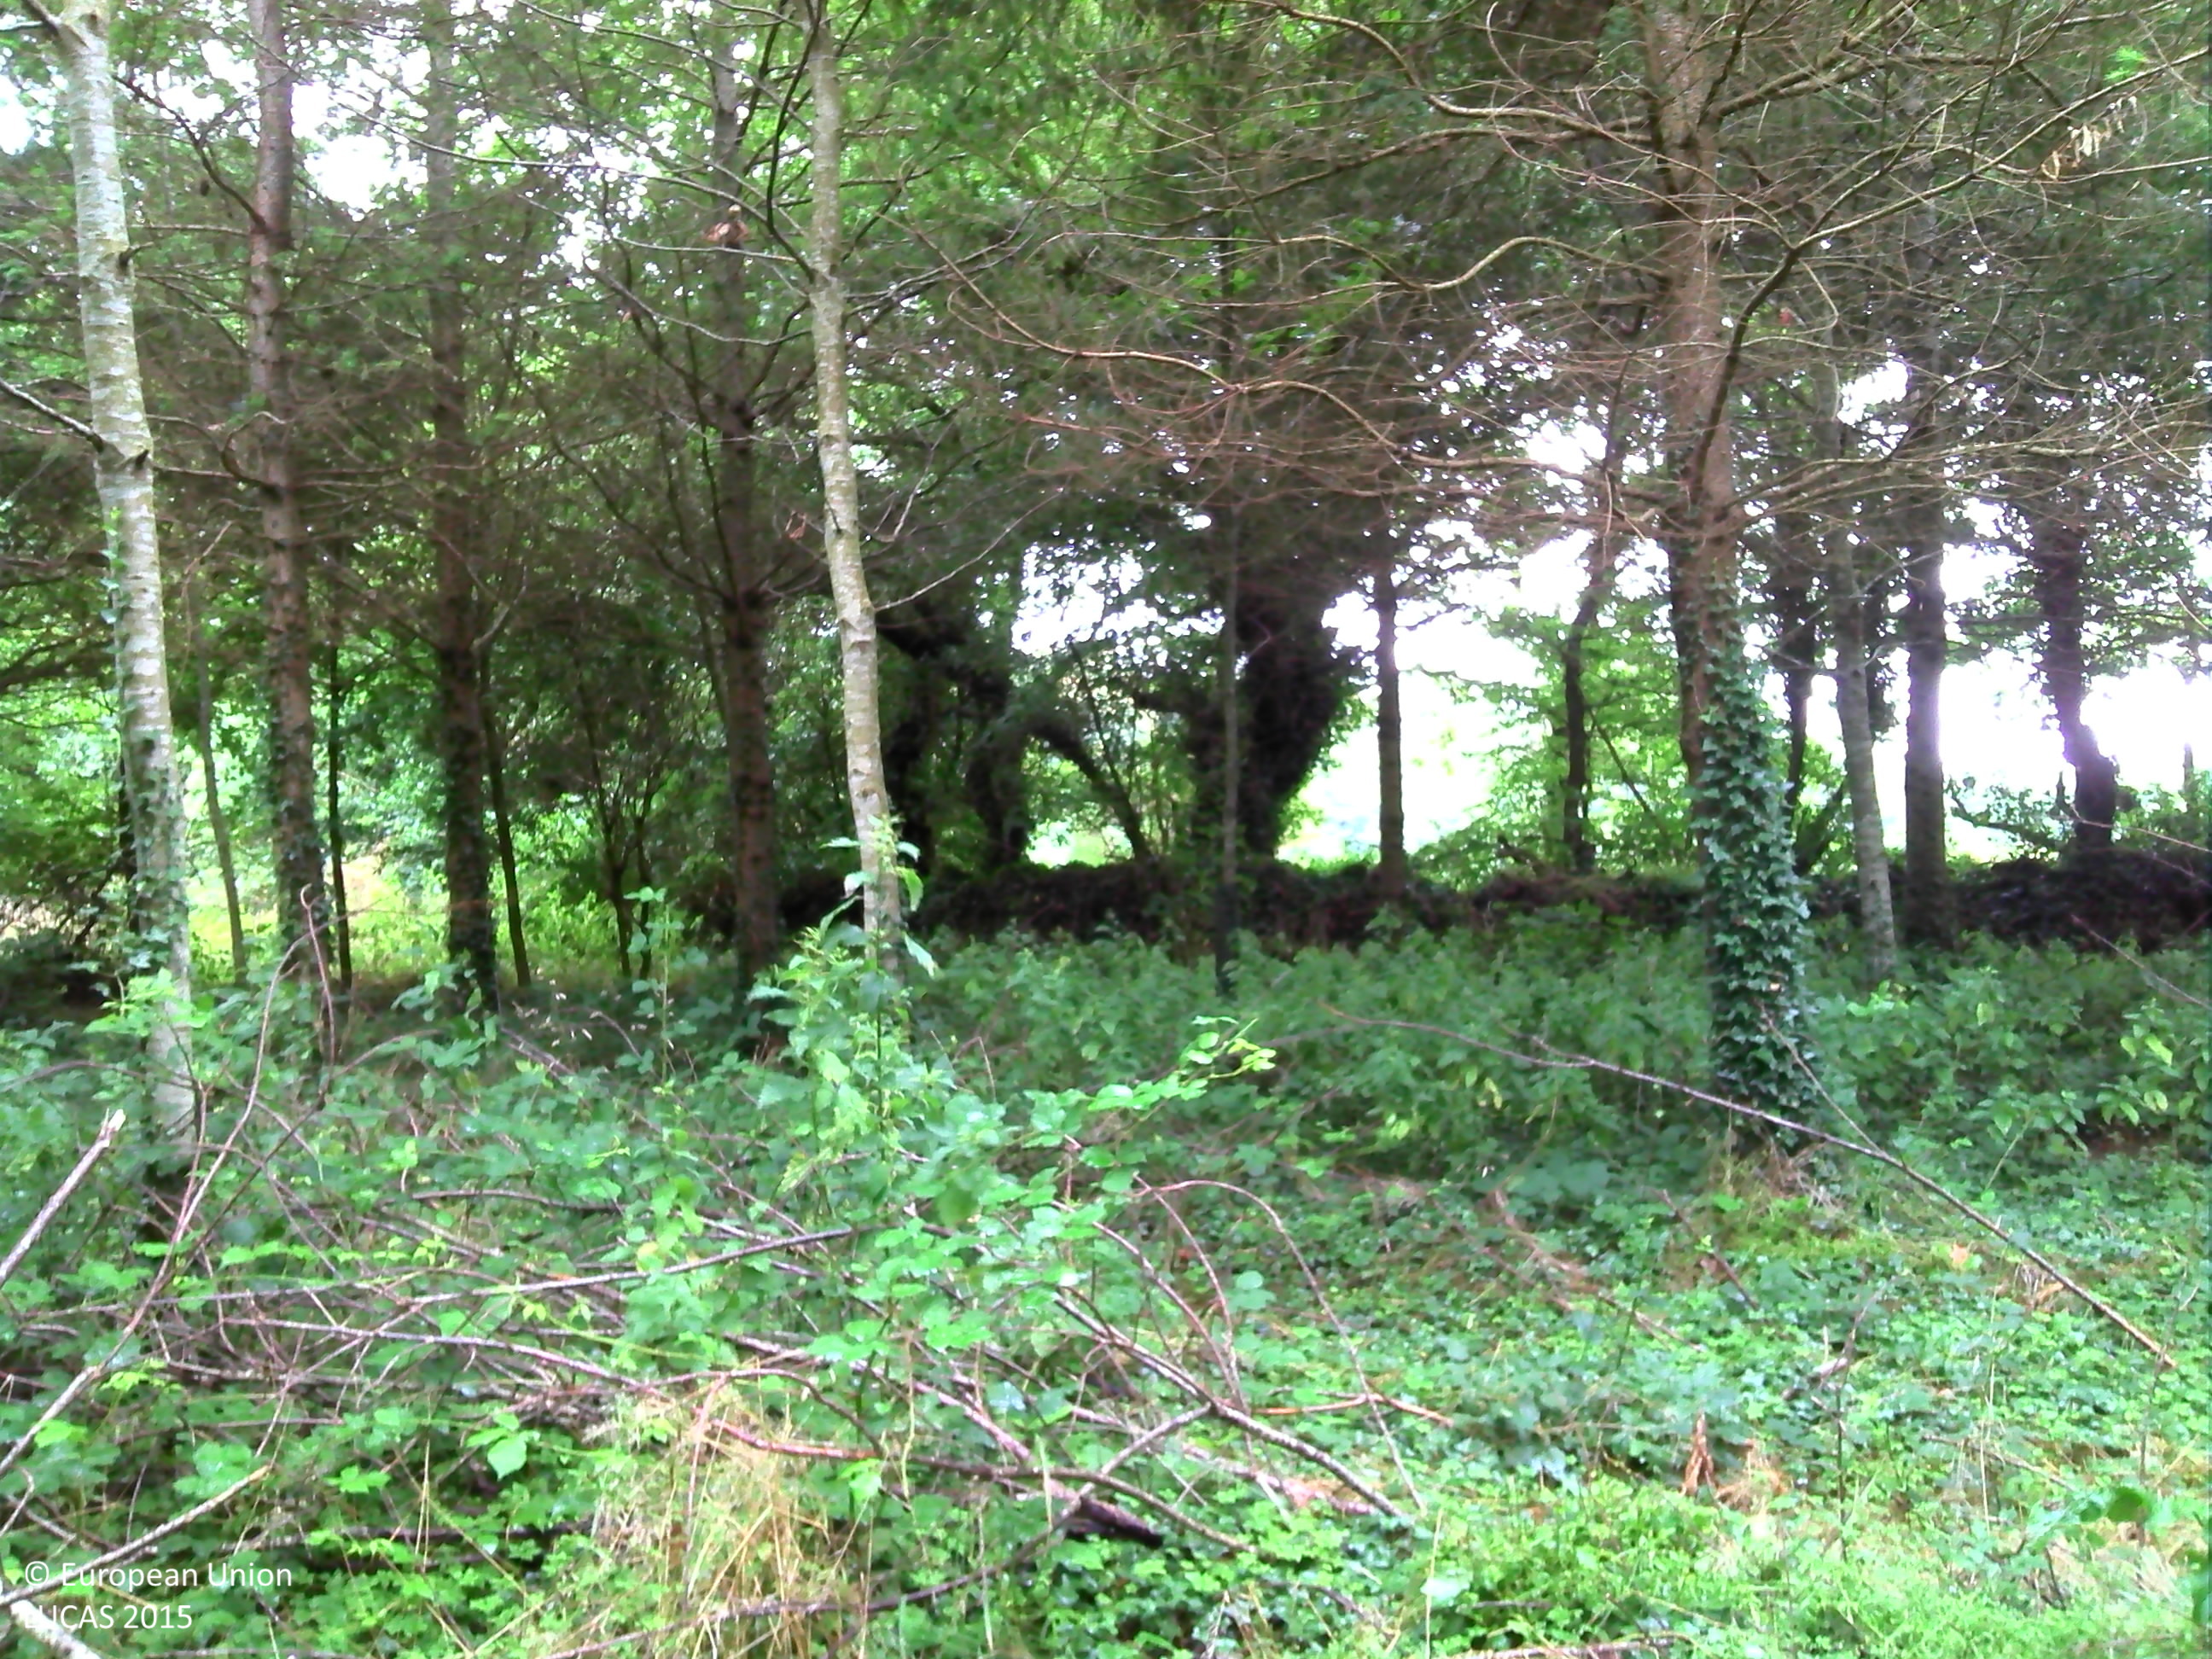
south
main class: Woodland
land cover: Spruce dominated mixed woodland
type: exotic forest
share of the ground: > 75 %
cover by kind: broadleaved forest trees 50 %, coniferous forest trees 25 %, shrubs 10 %, herbaceous plants 10 %, consolidated bare surface 5 %
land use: Forestry
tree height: > 5 m
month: July
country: FR
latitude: 47.9961
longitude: -3.6007
